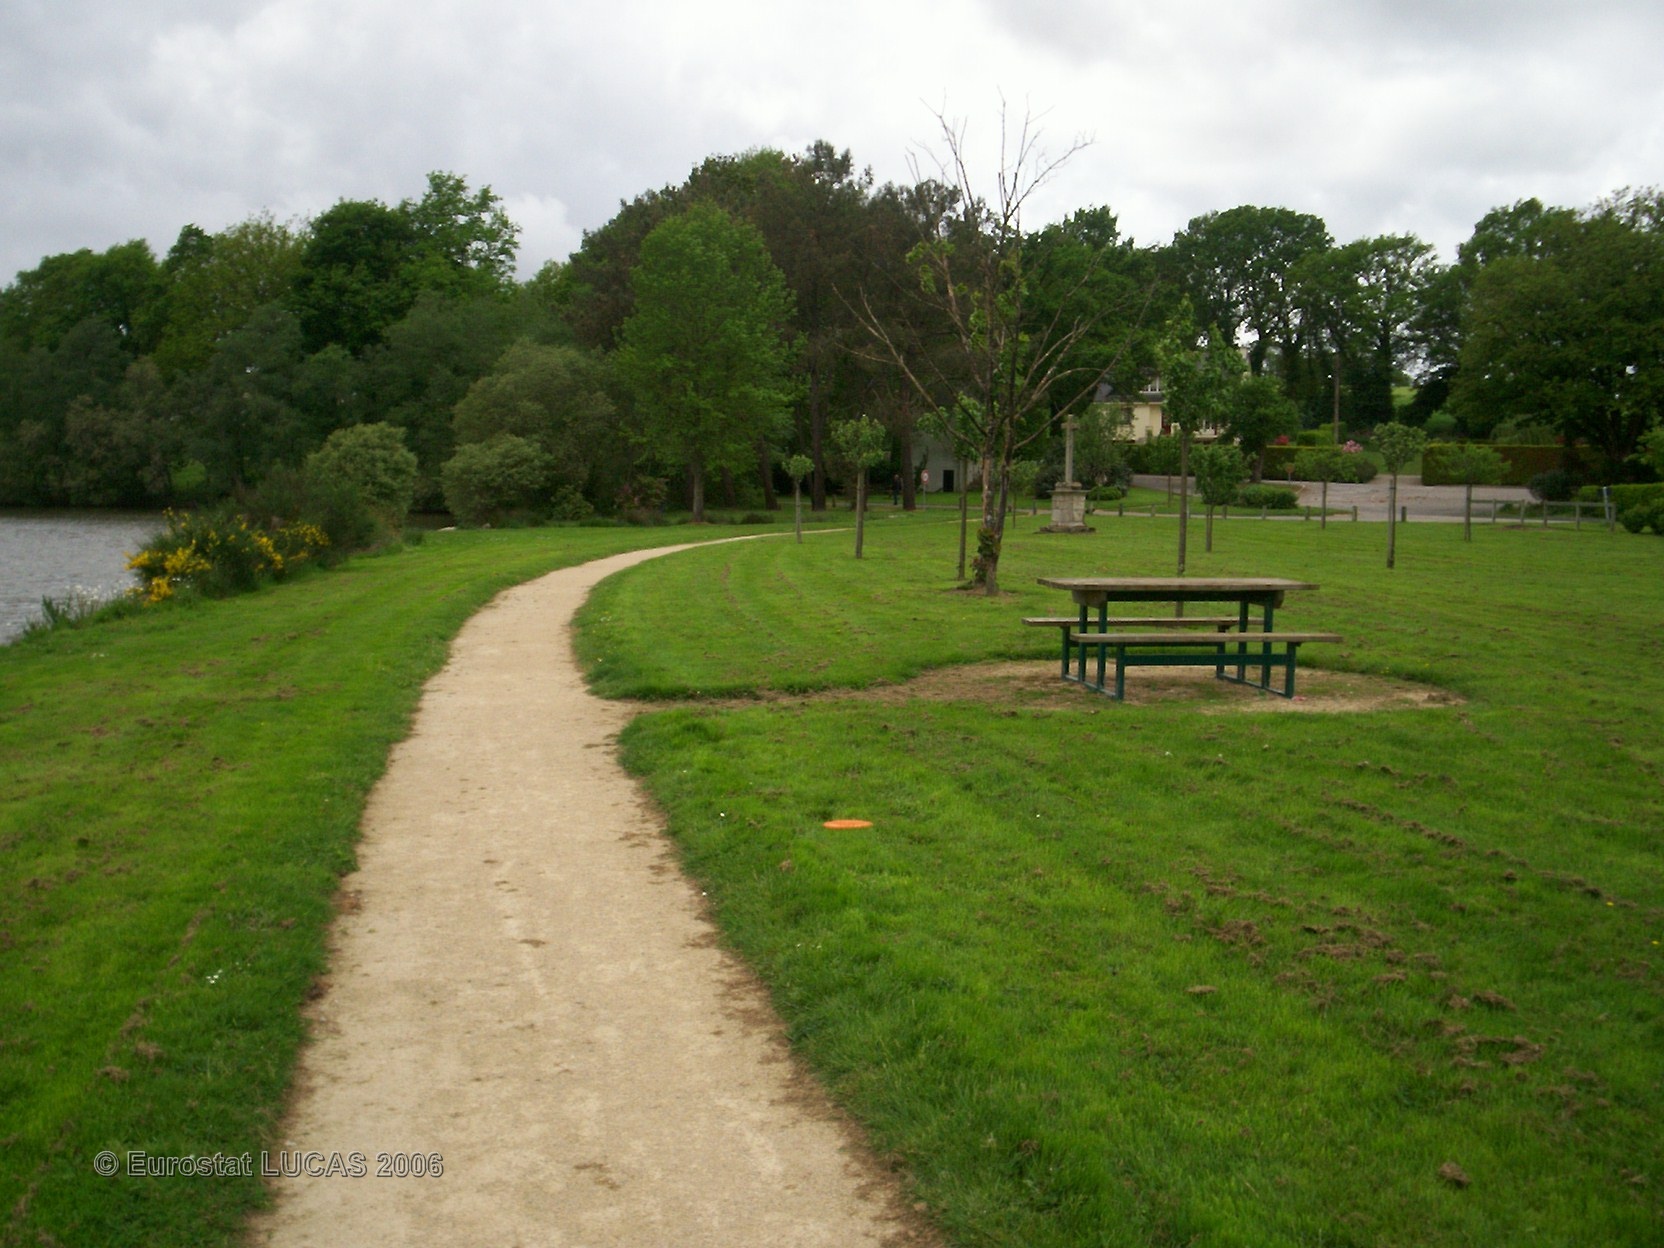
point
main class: Grassland
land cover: Grassland without tree/shrub cover
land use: Amenities, museums, leisure
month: May
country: FR
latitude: 47.9716
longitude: -2.7487
